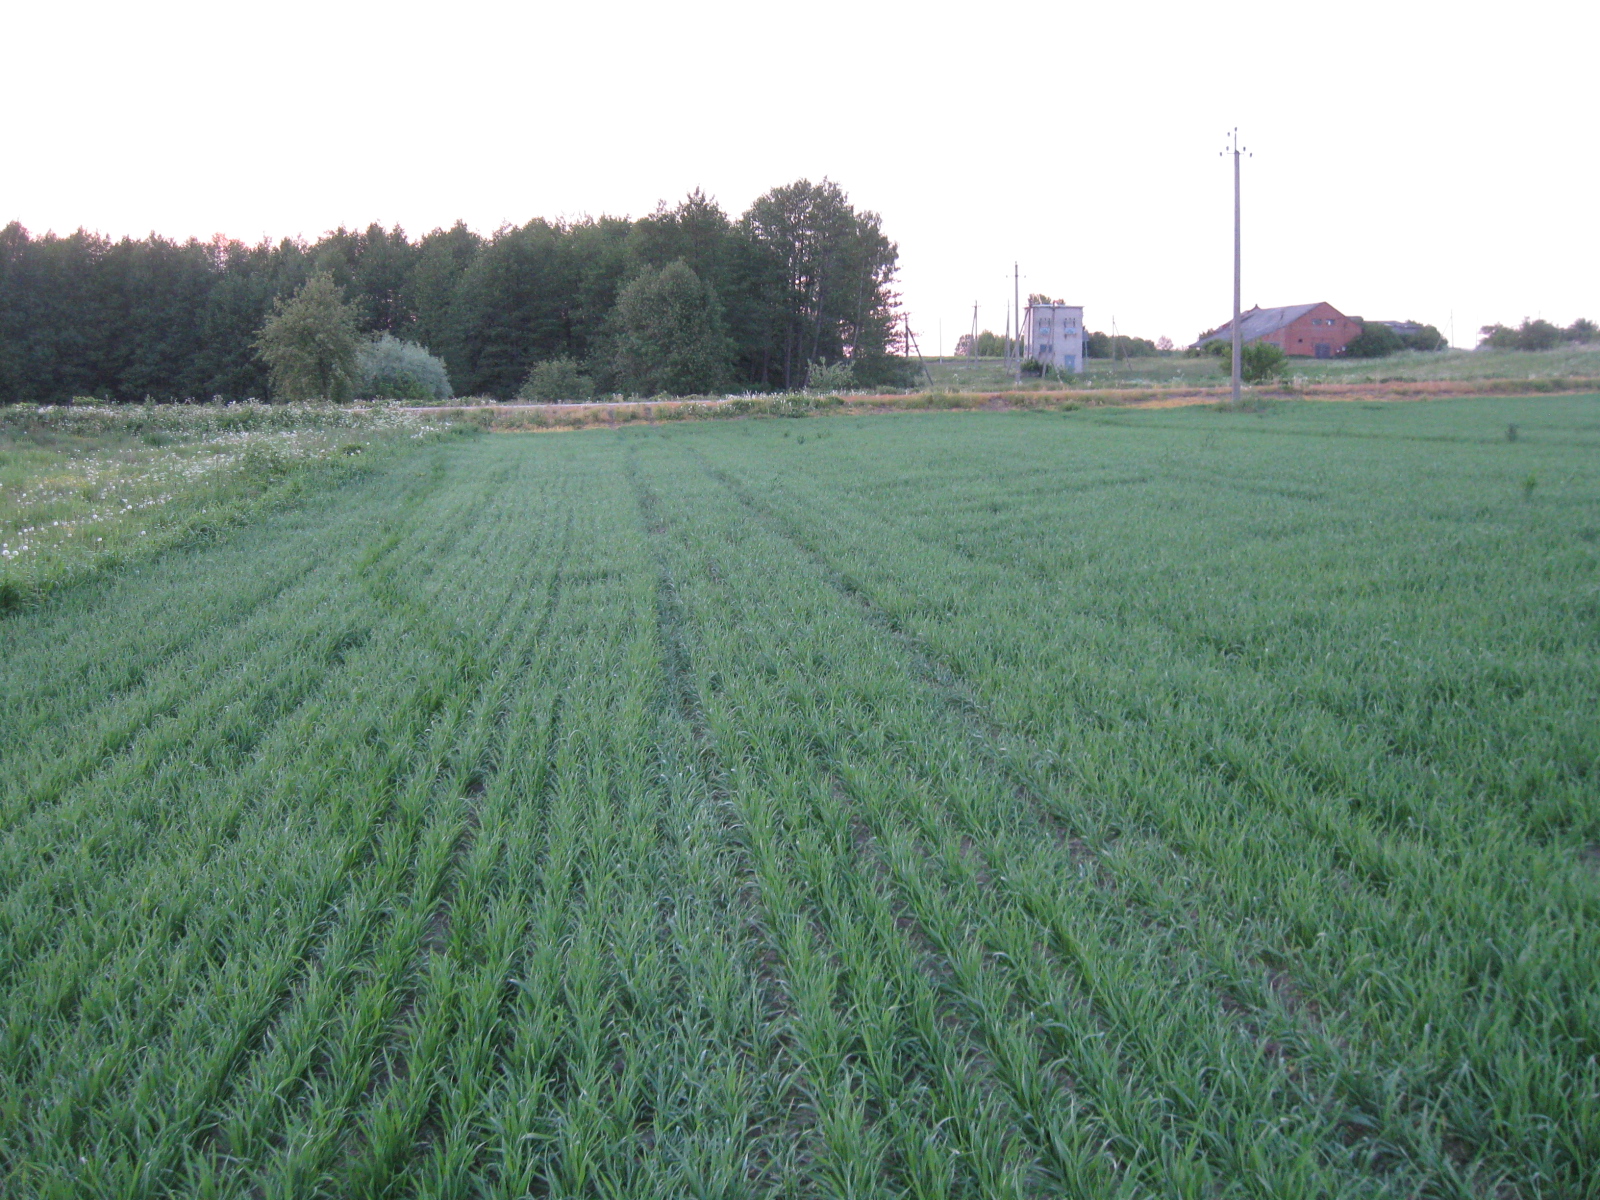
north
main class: Cropland
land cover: Common wheat
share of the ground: > 75 %
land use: Agriculture (excluding fallow land and kitchen gardens)
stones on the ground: < 10 %
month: May
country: LT
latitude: 54.5306
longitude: 22.7235
